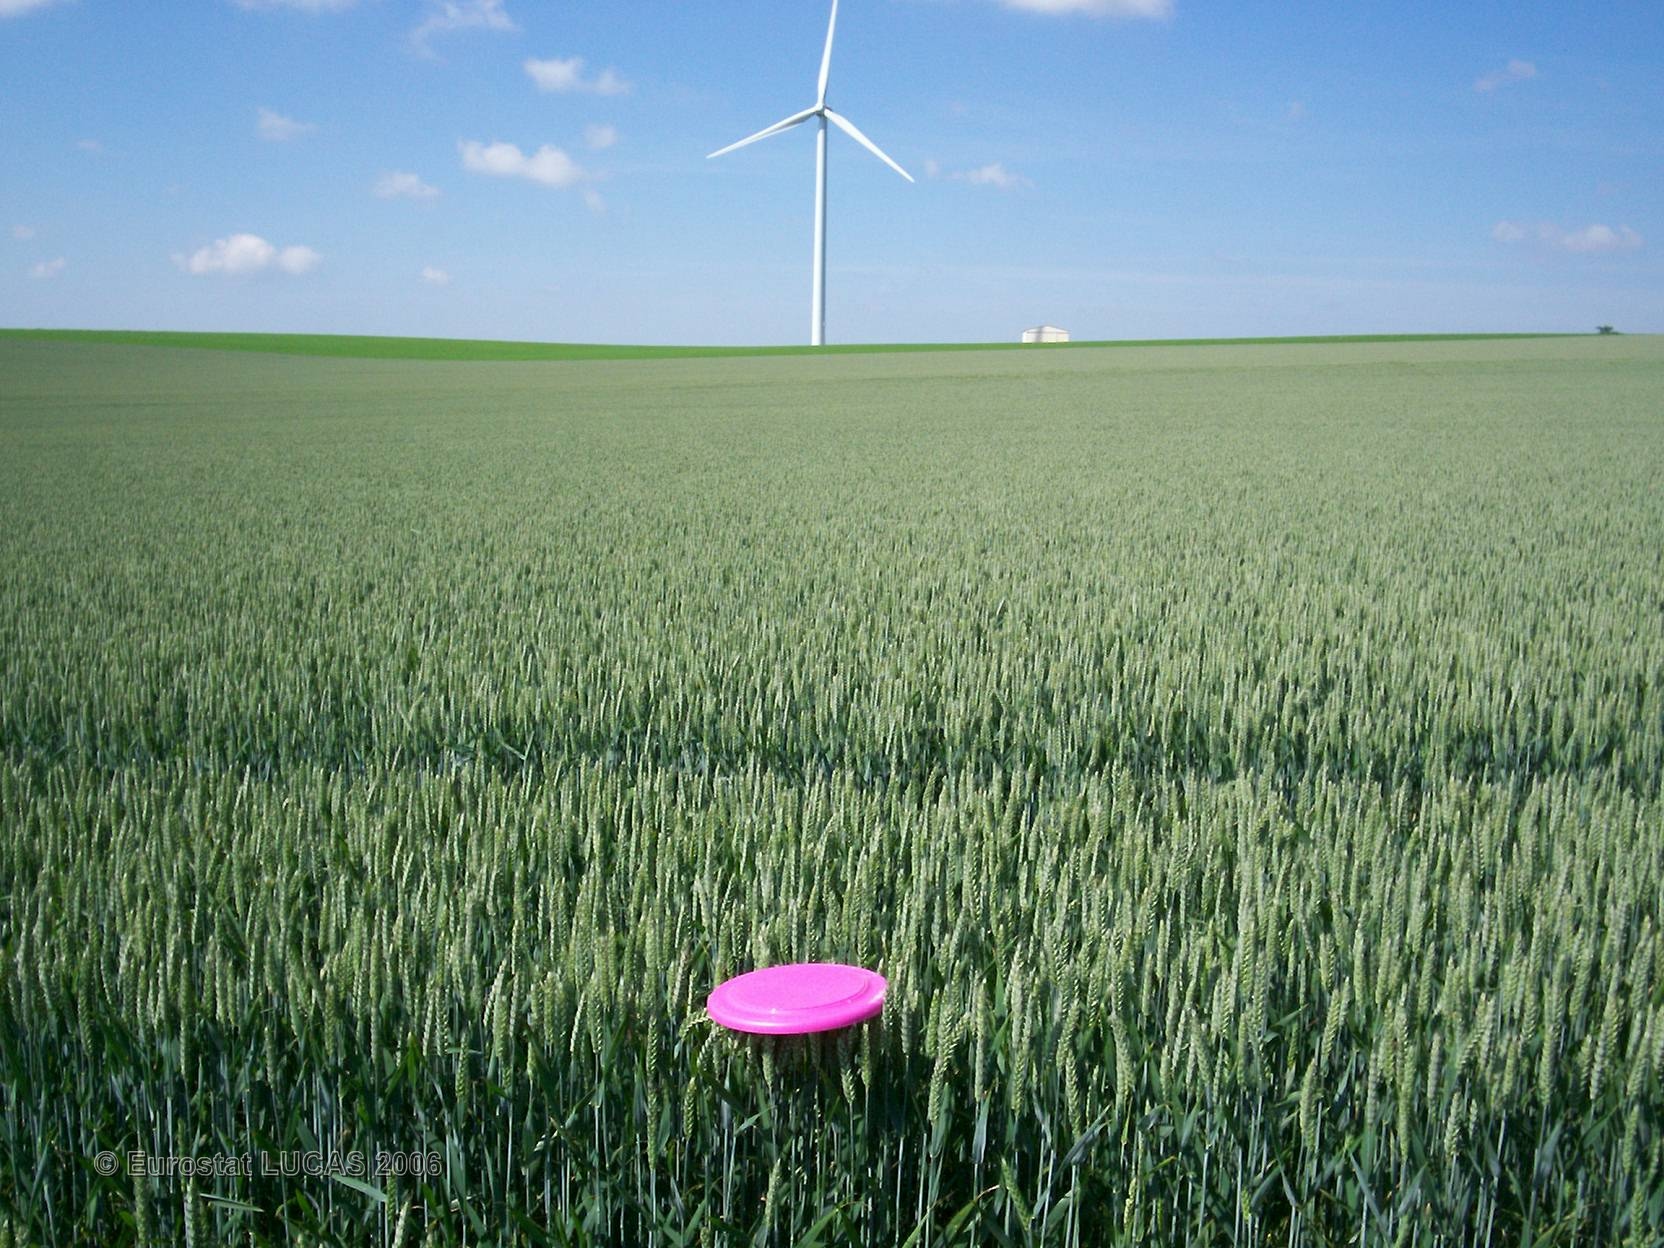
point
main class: Cropland
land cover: Common wheat
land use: Agriculture (excluding fallow land and kitchen gardens)
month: June
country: FR
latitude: 48.8206
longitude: 4.3988
